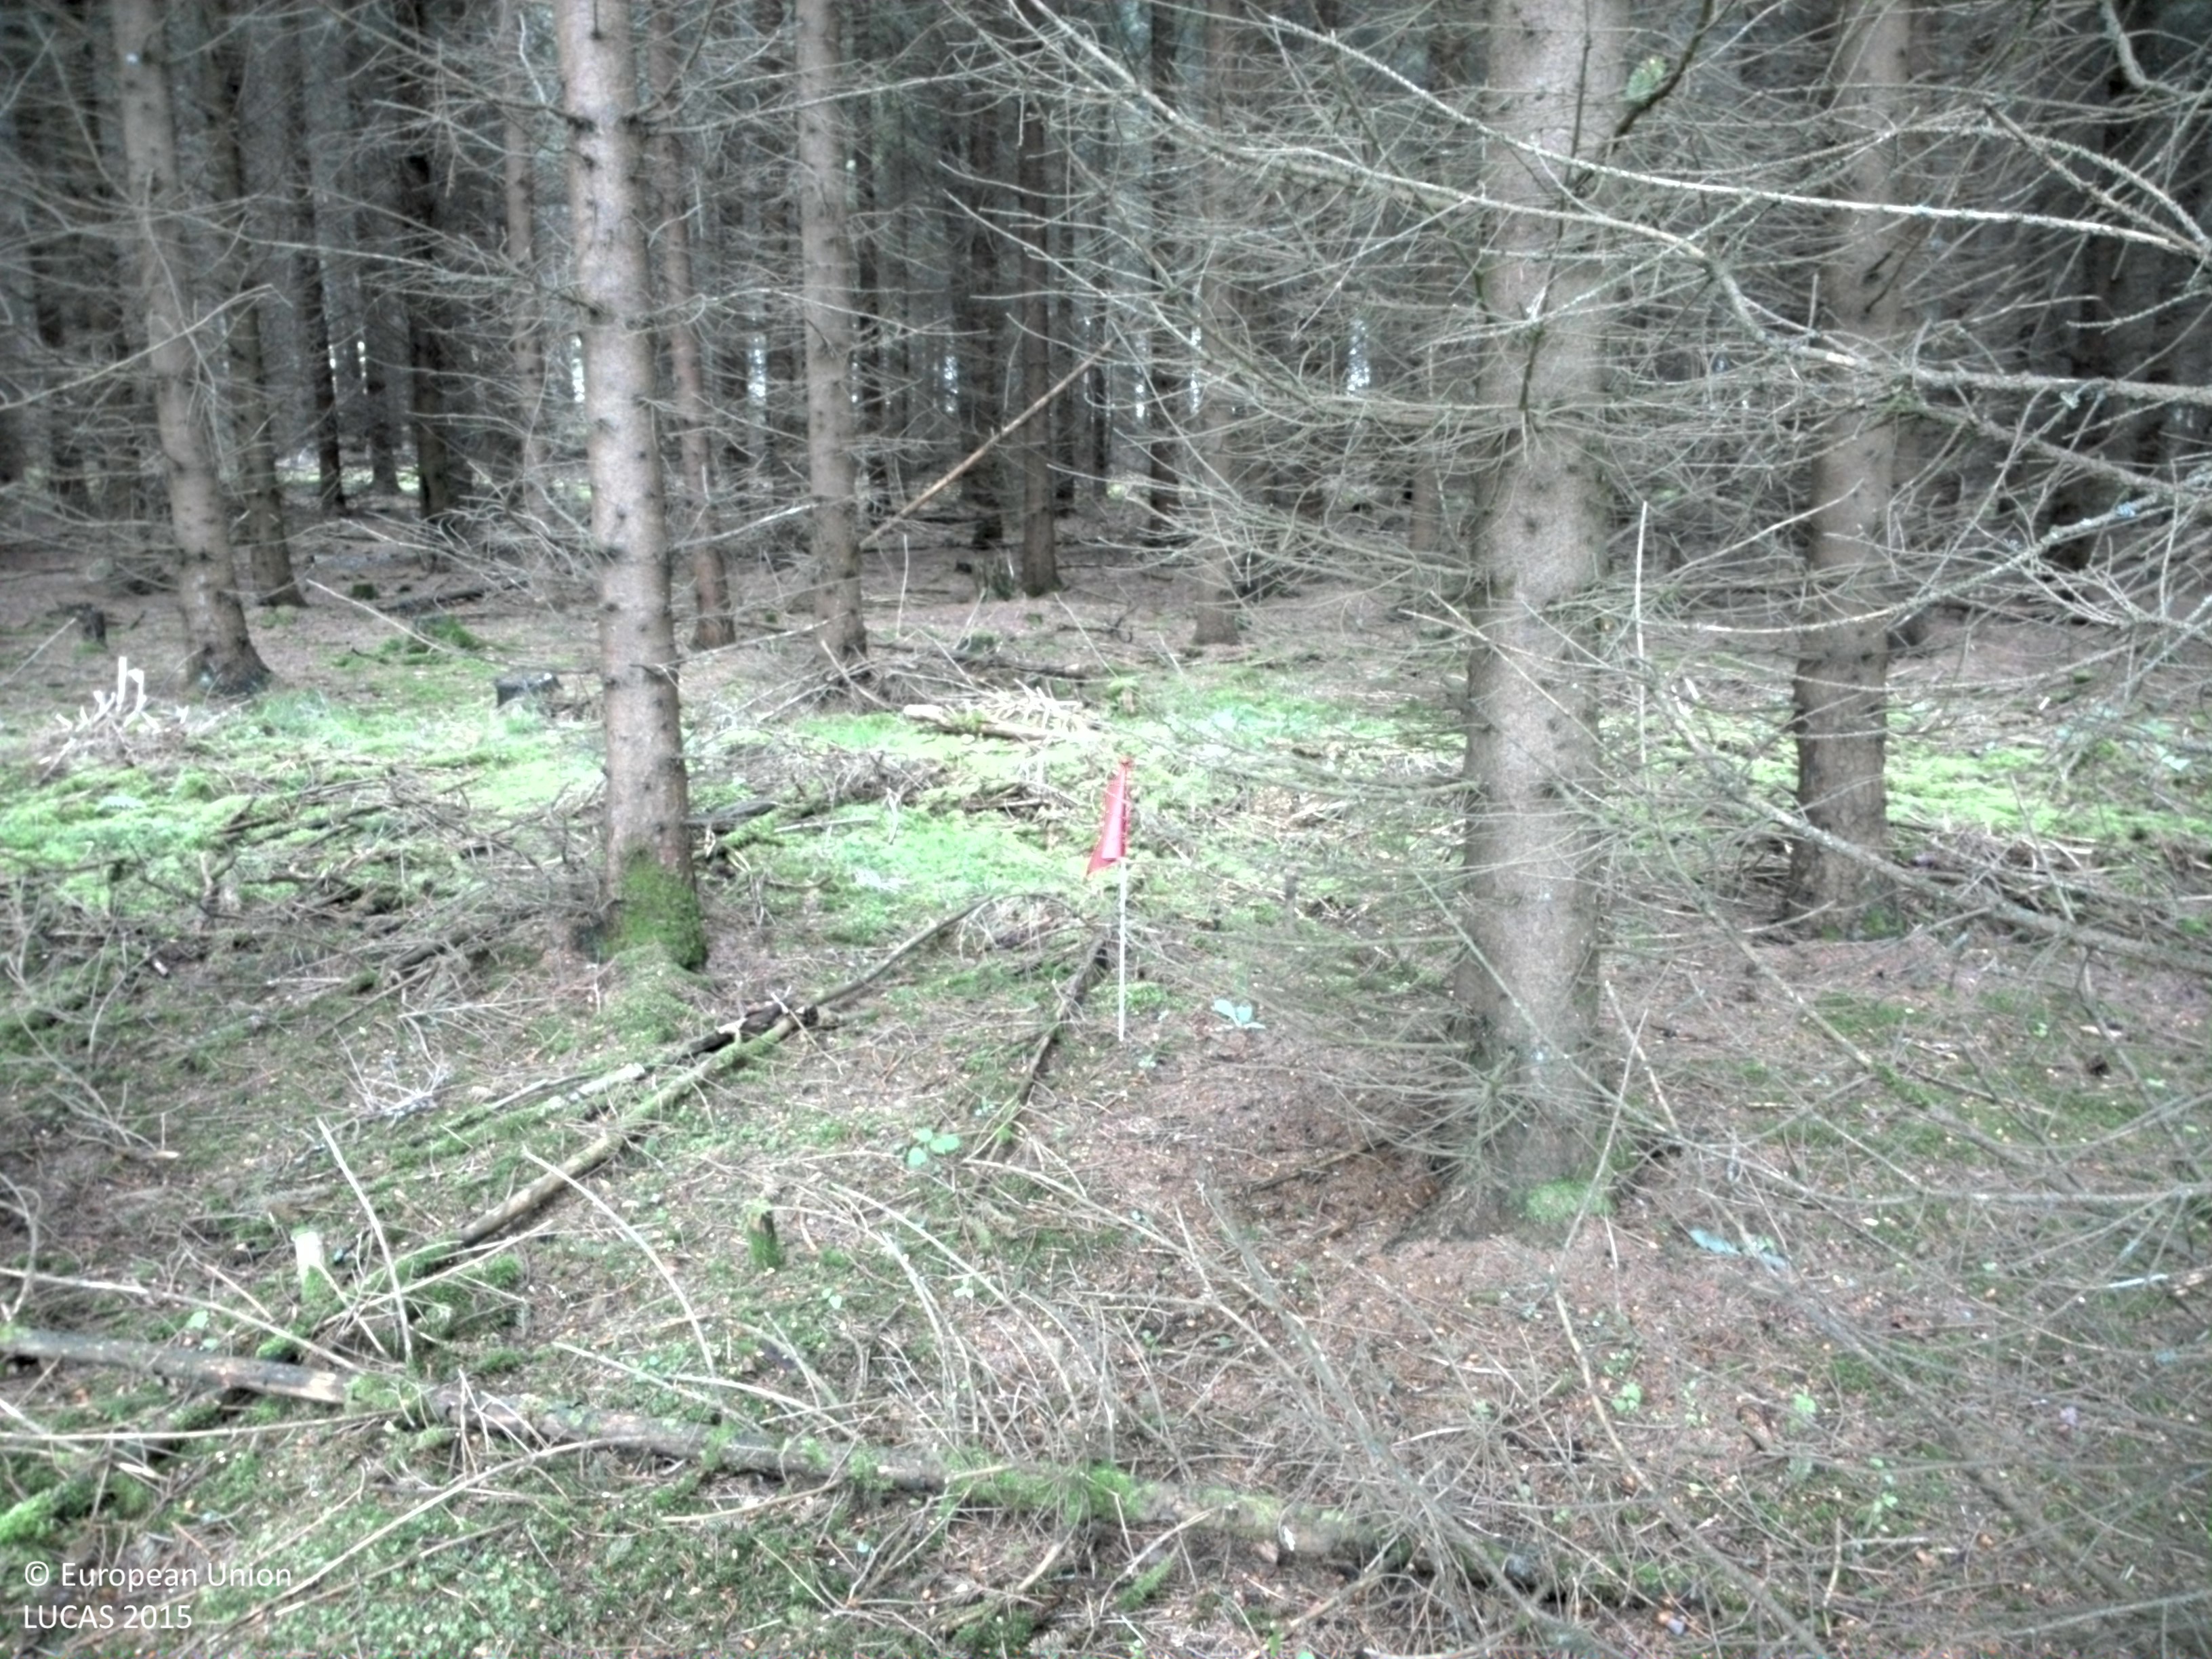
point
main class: Woodland
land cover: Spruce dominated coniferous woodland
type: boreal forest
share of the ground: > 75 %
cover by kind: coniferous forest trees 90 %, herbaceous plants 5 %, lichens and mosses 5 %
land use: Forestry
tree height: > 5 m
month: June
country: SE
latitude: 58.2531
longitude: 13.8962
